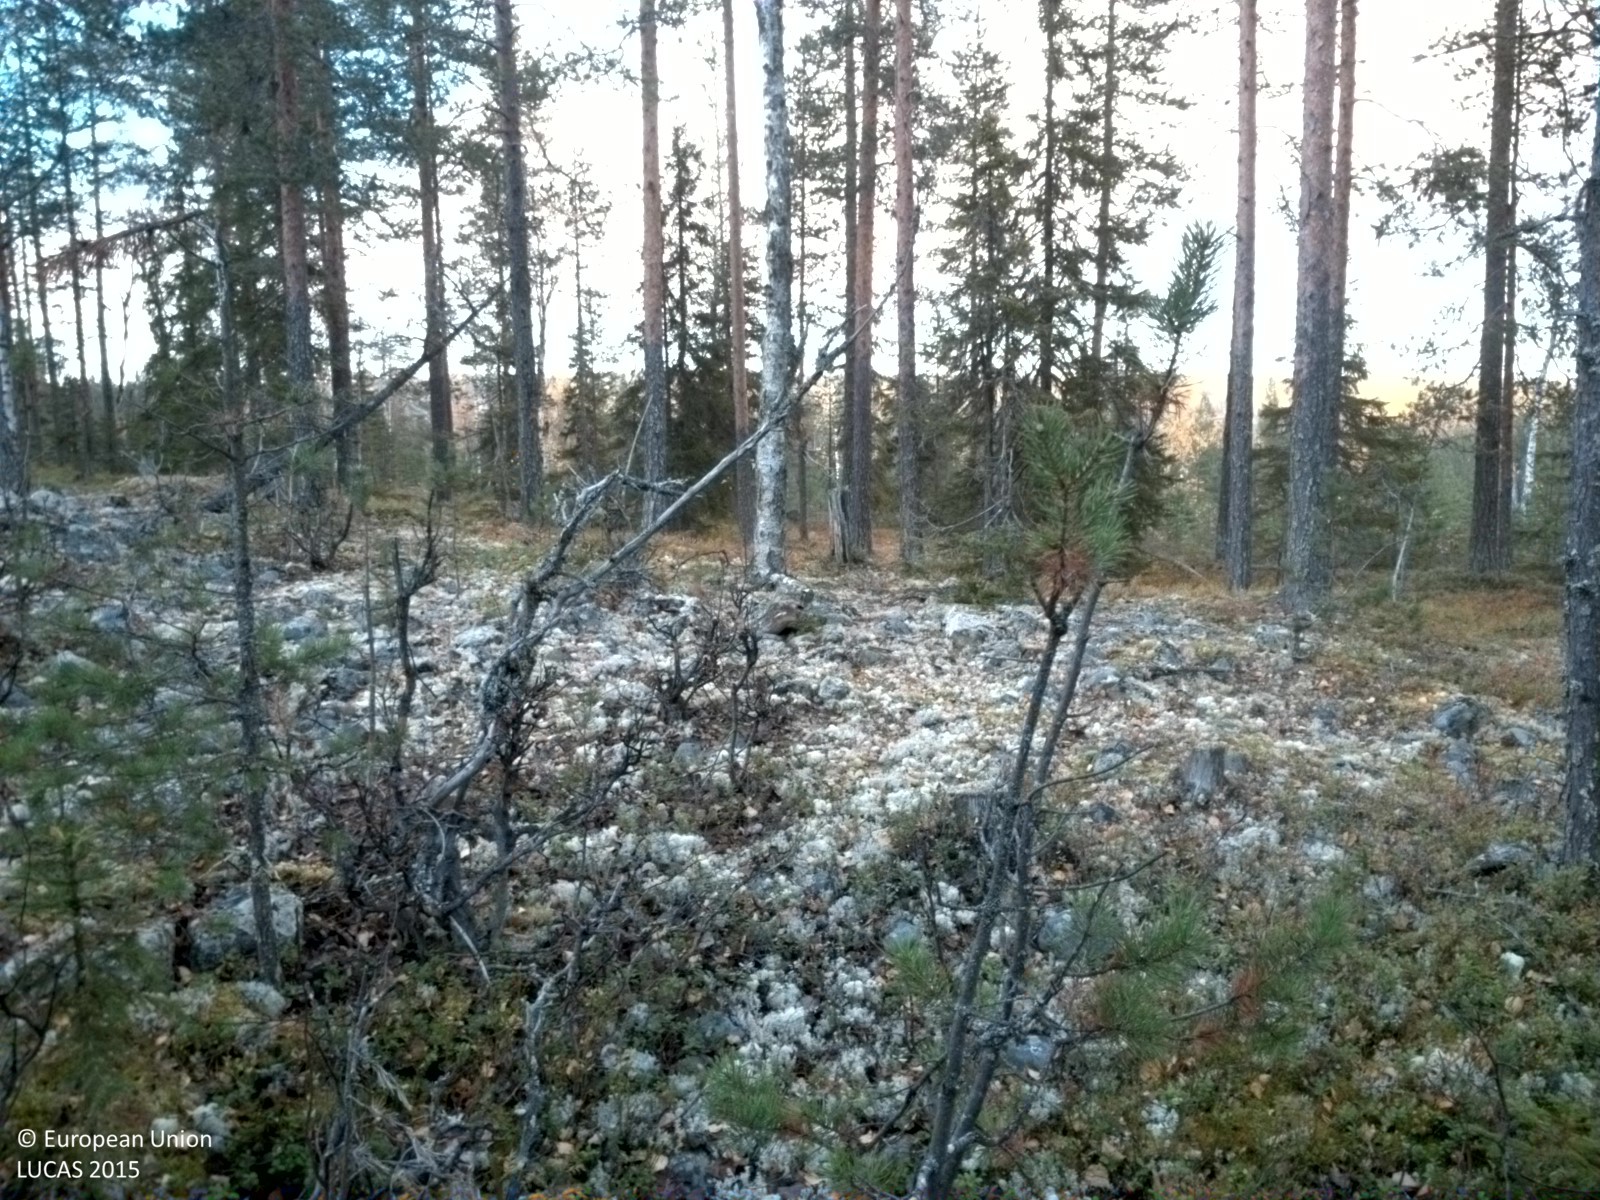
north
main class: Woodland
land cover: Pine dominated coniferous woodland
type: boreal forest
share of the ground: 25 - 50 %
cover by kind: shrubs 50 %, coniferous forest trees 30 %, lichens and mosses 10 %, consolidated bare surface 10 %
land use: Forestry
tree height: > 5 m
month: October
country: SE
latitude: 65.9891
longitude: 22.0649
